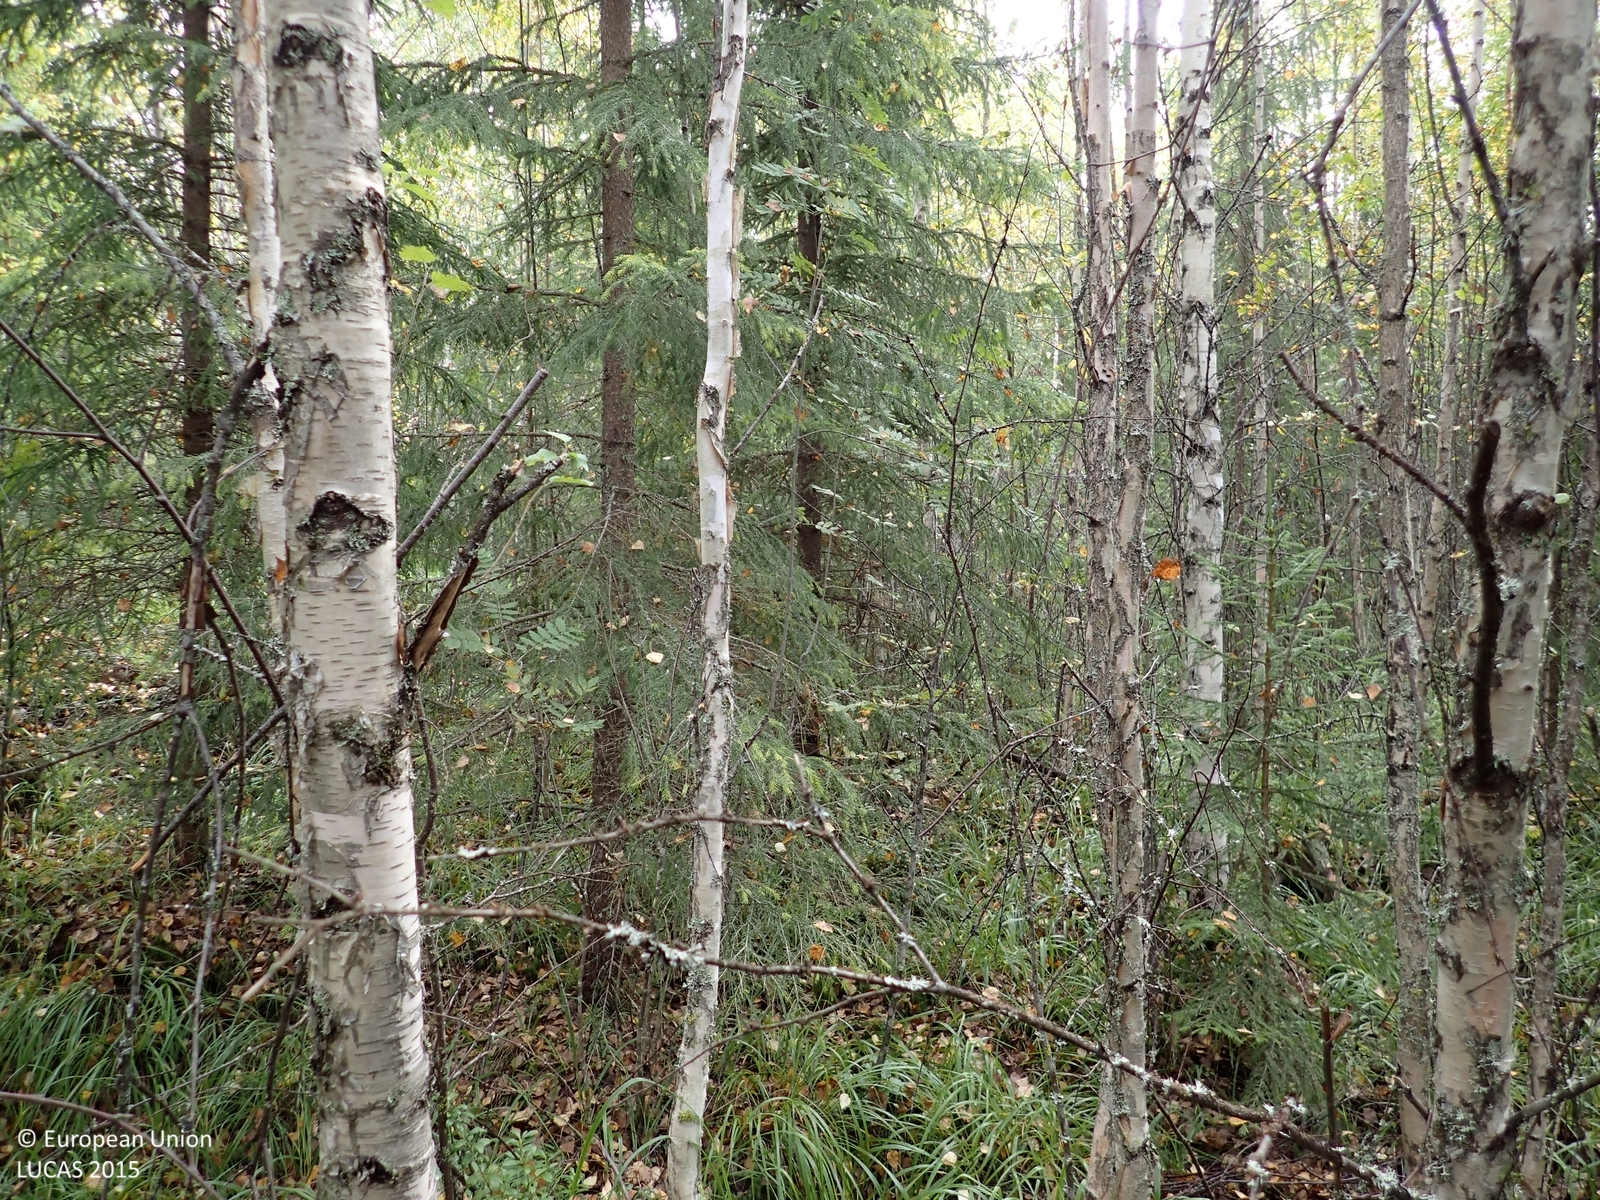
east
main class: Woodland
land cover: Spruce dominated mixed woodland
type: boreal forest
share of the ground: > 75 %
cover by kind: broadleaved forest trees 55 %, coniferous forest trees 30 %, herbaceous plants 10 %, lichens and mosses 5 %
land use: Forestry
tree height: > 5 m
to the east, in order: Spruce dominated mixed woodland; Other mixed woodland
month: September
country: FI
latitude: 63.0772
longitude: 26.0147
